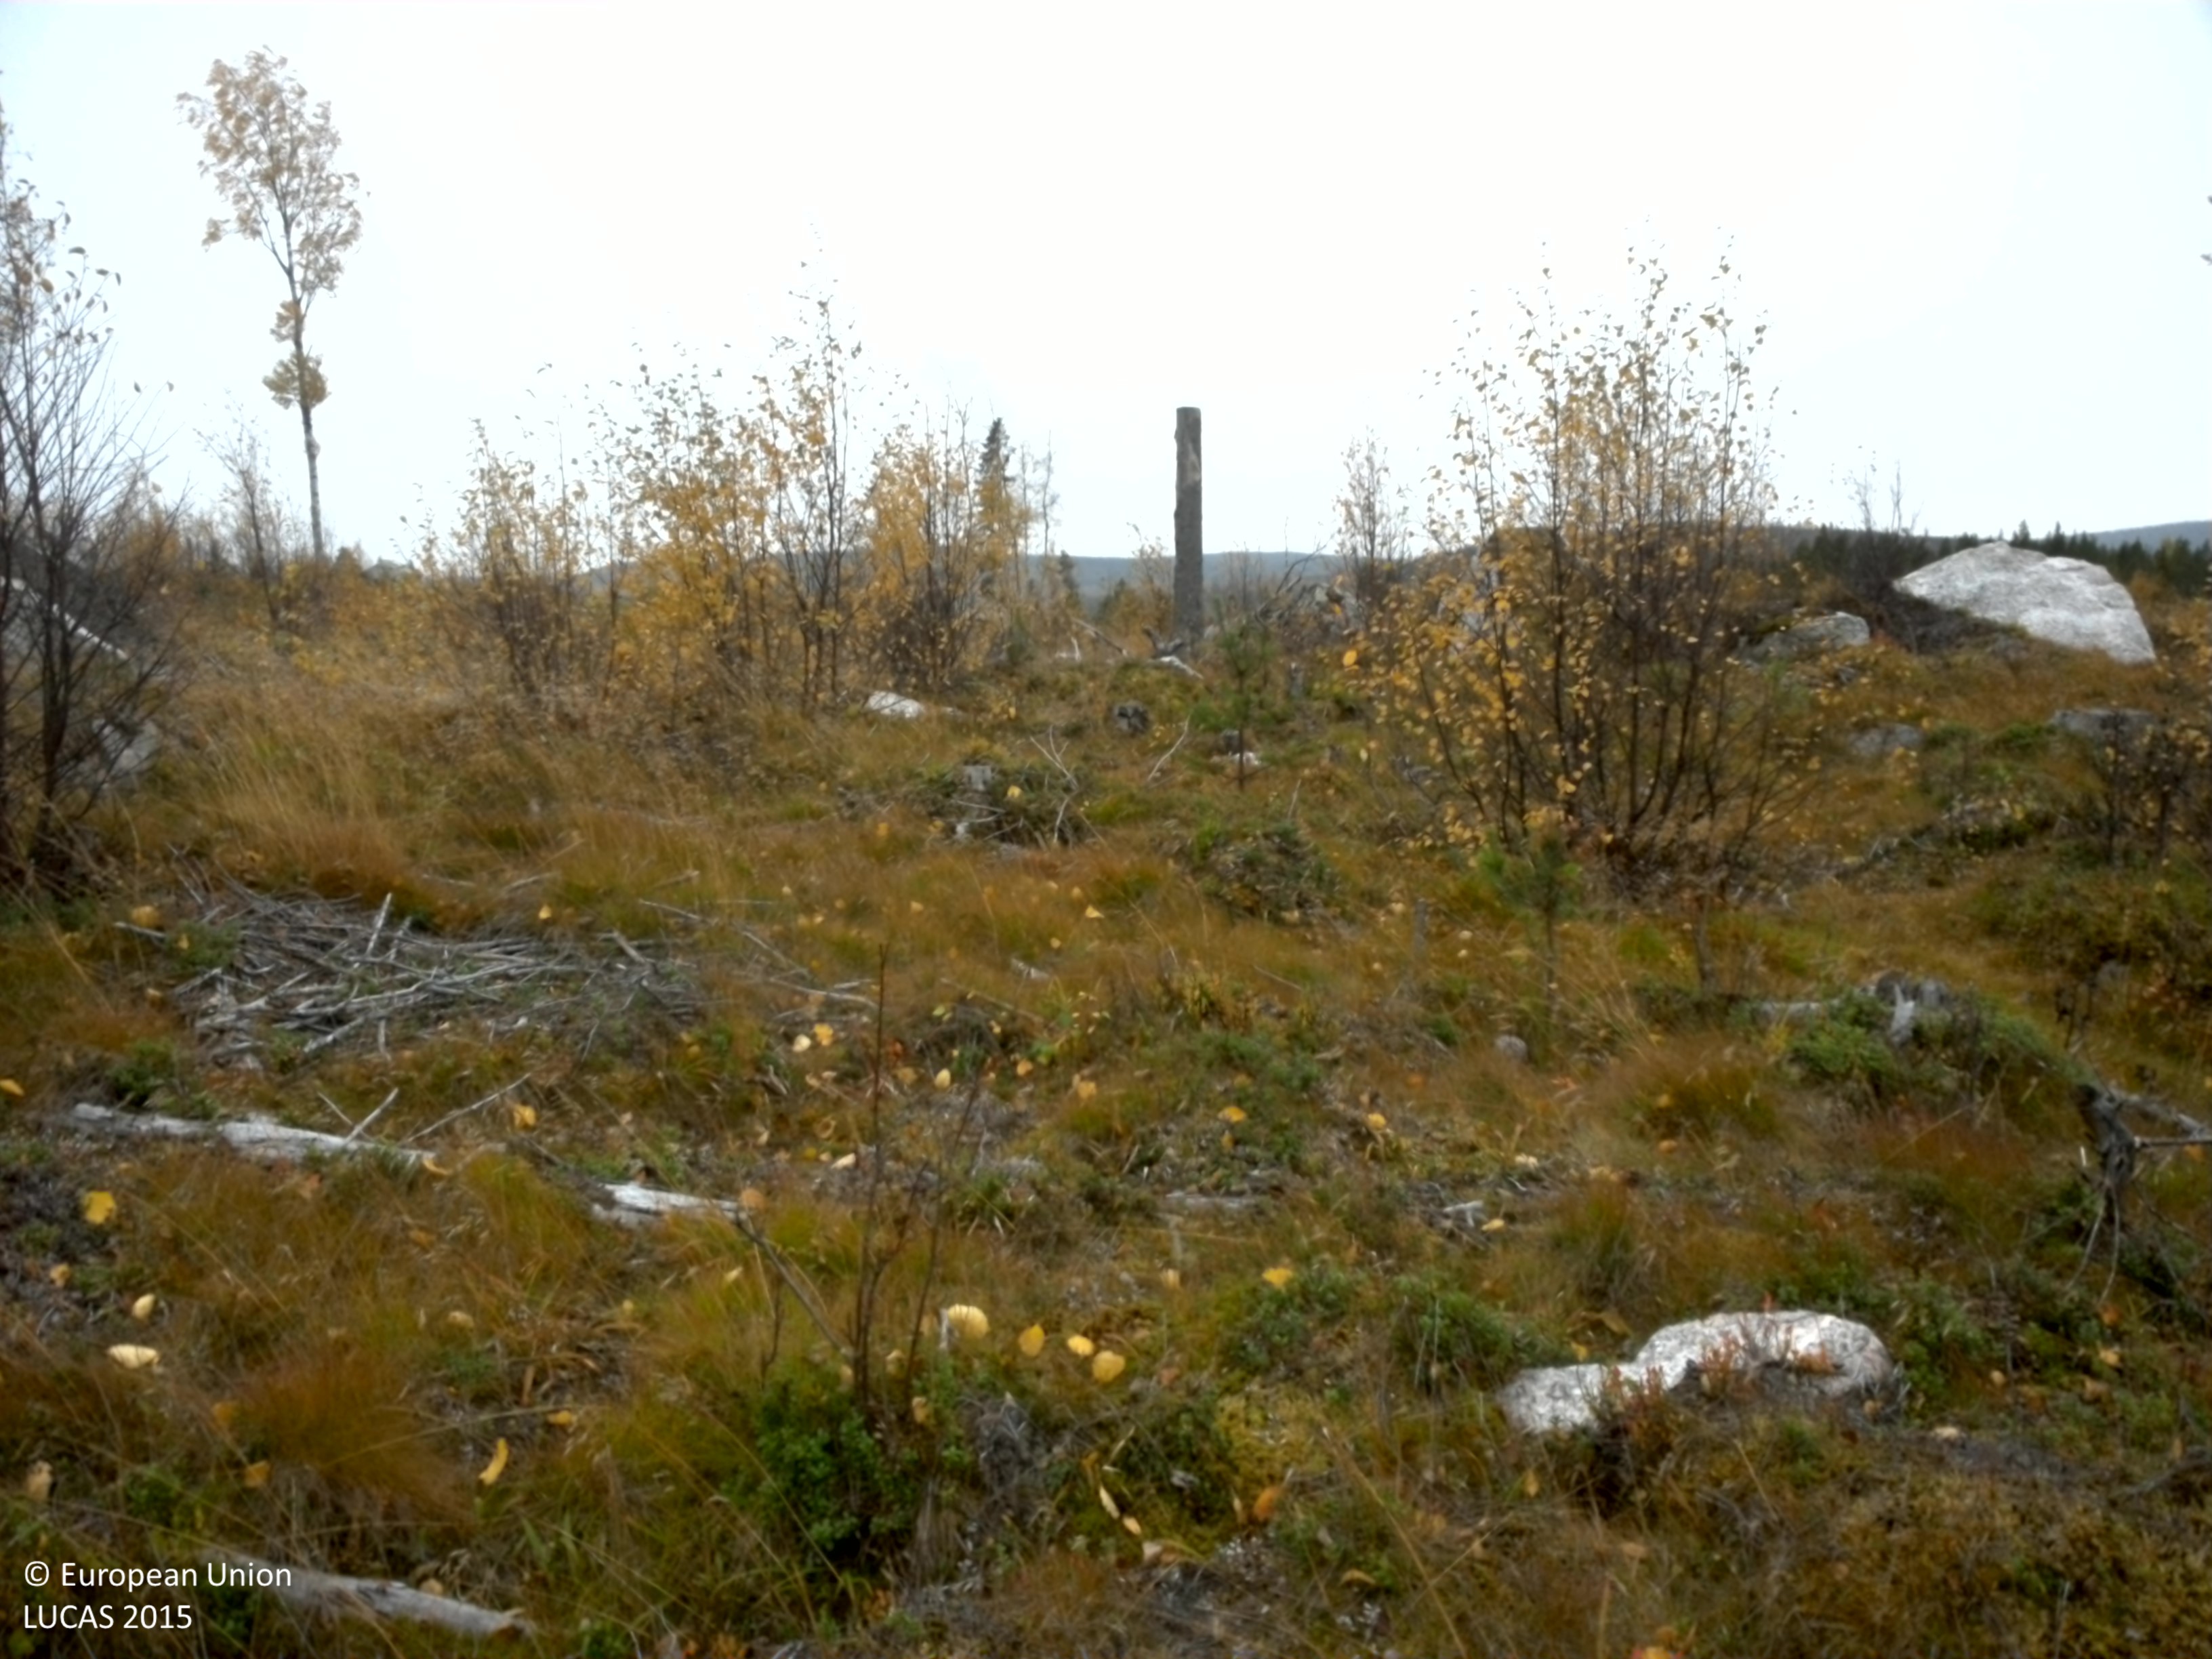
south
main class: Woodland
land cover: Broadleaved woodland
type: non-riverine alder, birch or aspen forest
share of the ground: 10 - 25 %
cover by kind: herbaceous plants 65 %, lichens and mosses 15 %, broadleaved forest trees 10 %, shrubs 5 %, unconsolidated bare surface 5 %
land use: Forestry
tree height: < 5 m
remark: Clear cut
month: October
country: SE
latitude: 64.9480
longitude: 17.4777
